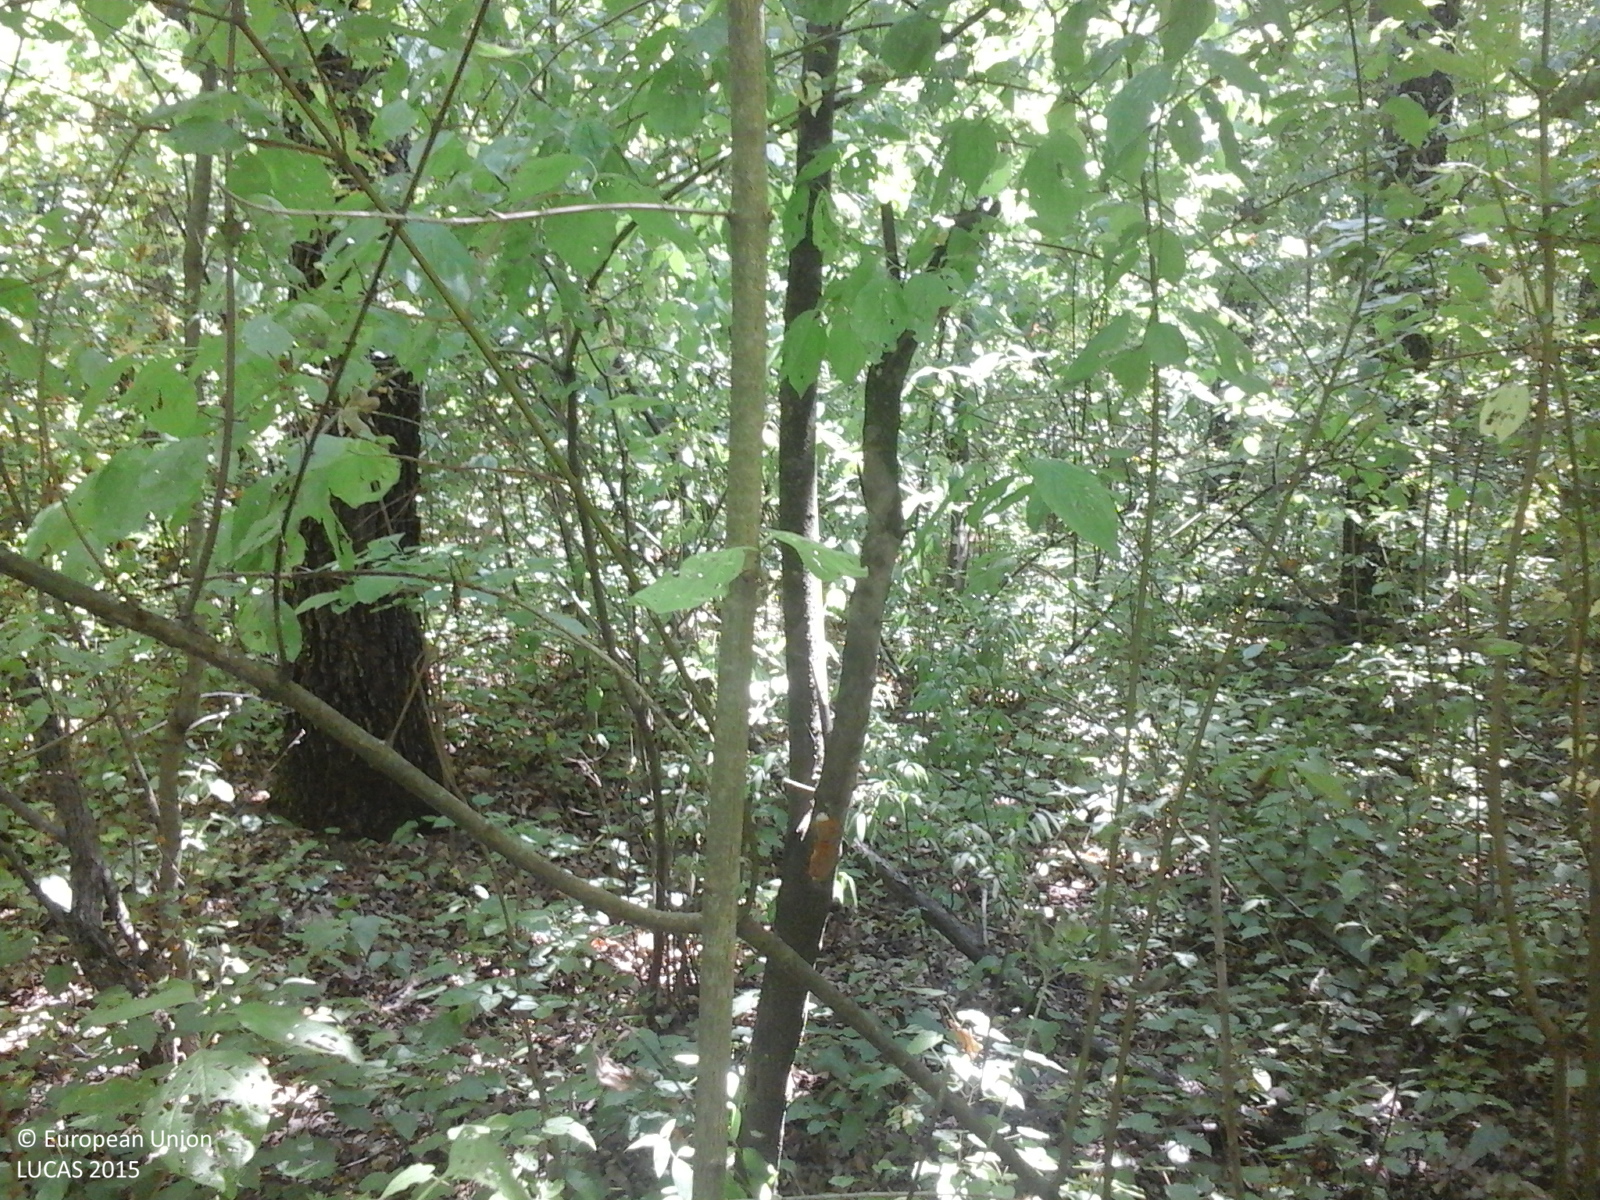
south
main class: Woodland
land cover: Broadleaved woodland
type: acidophilous oak and oak-birch forest
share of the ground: > 75 %
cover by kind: broadleaved forest trees 100 %
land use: Forestry
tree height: > 5 m
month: July
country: RO
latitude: 44.2411
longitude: 26.5553
